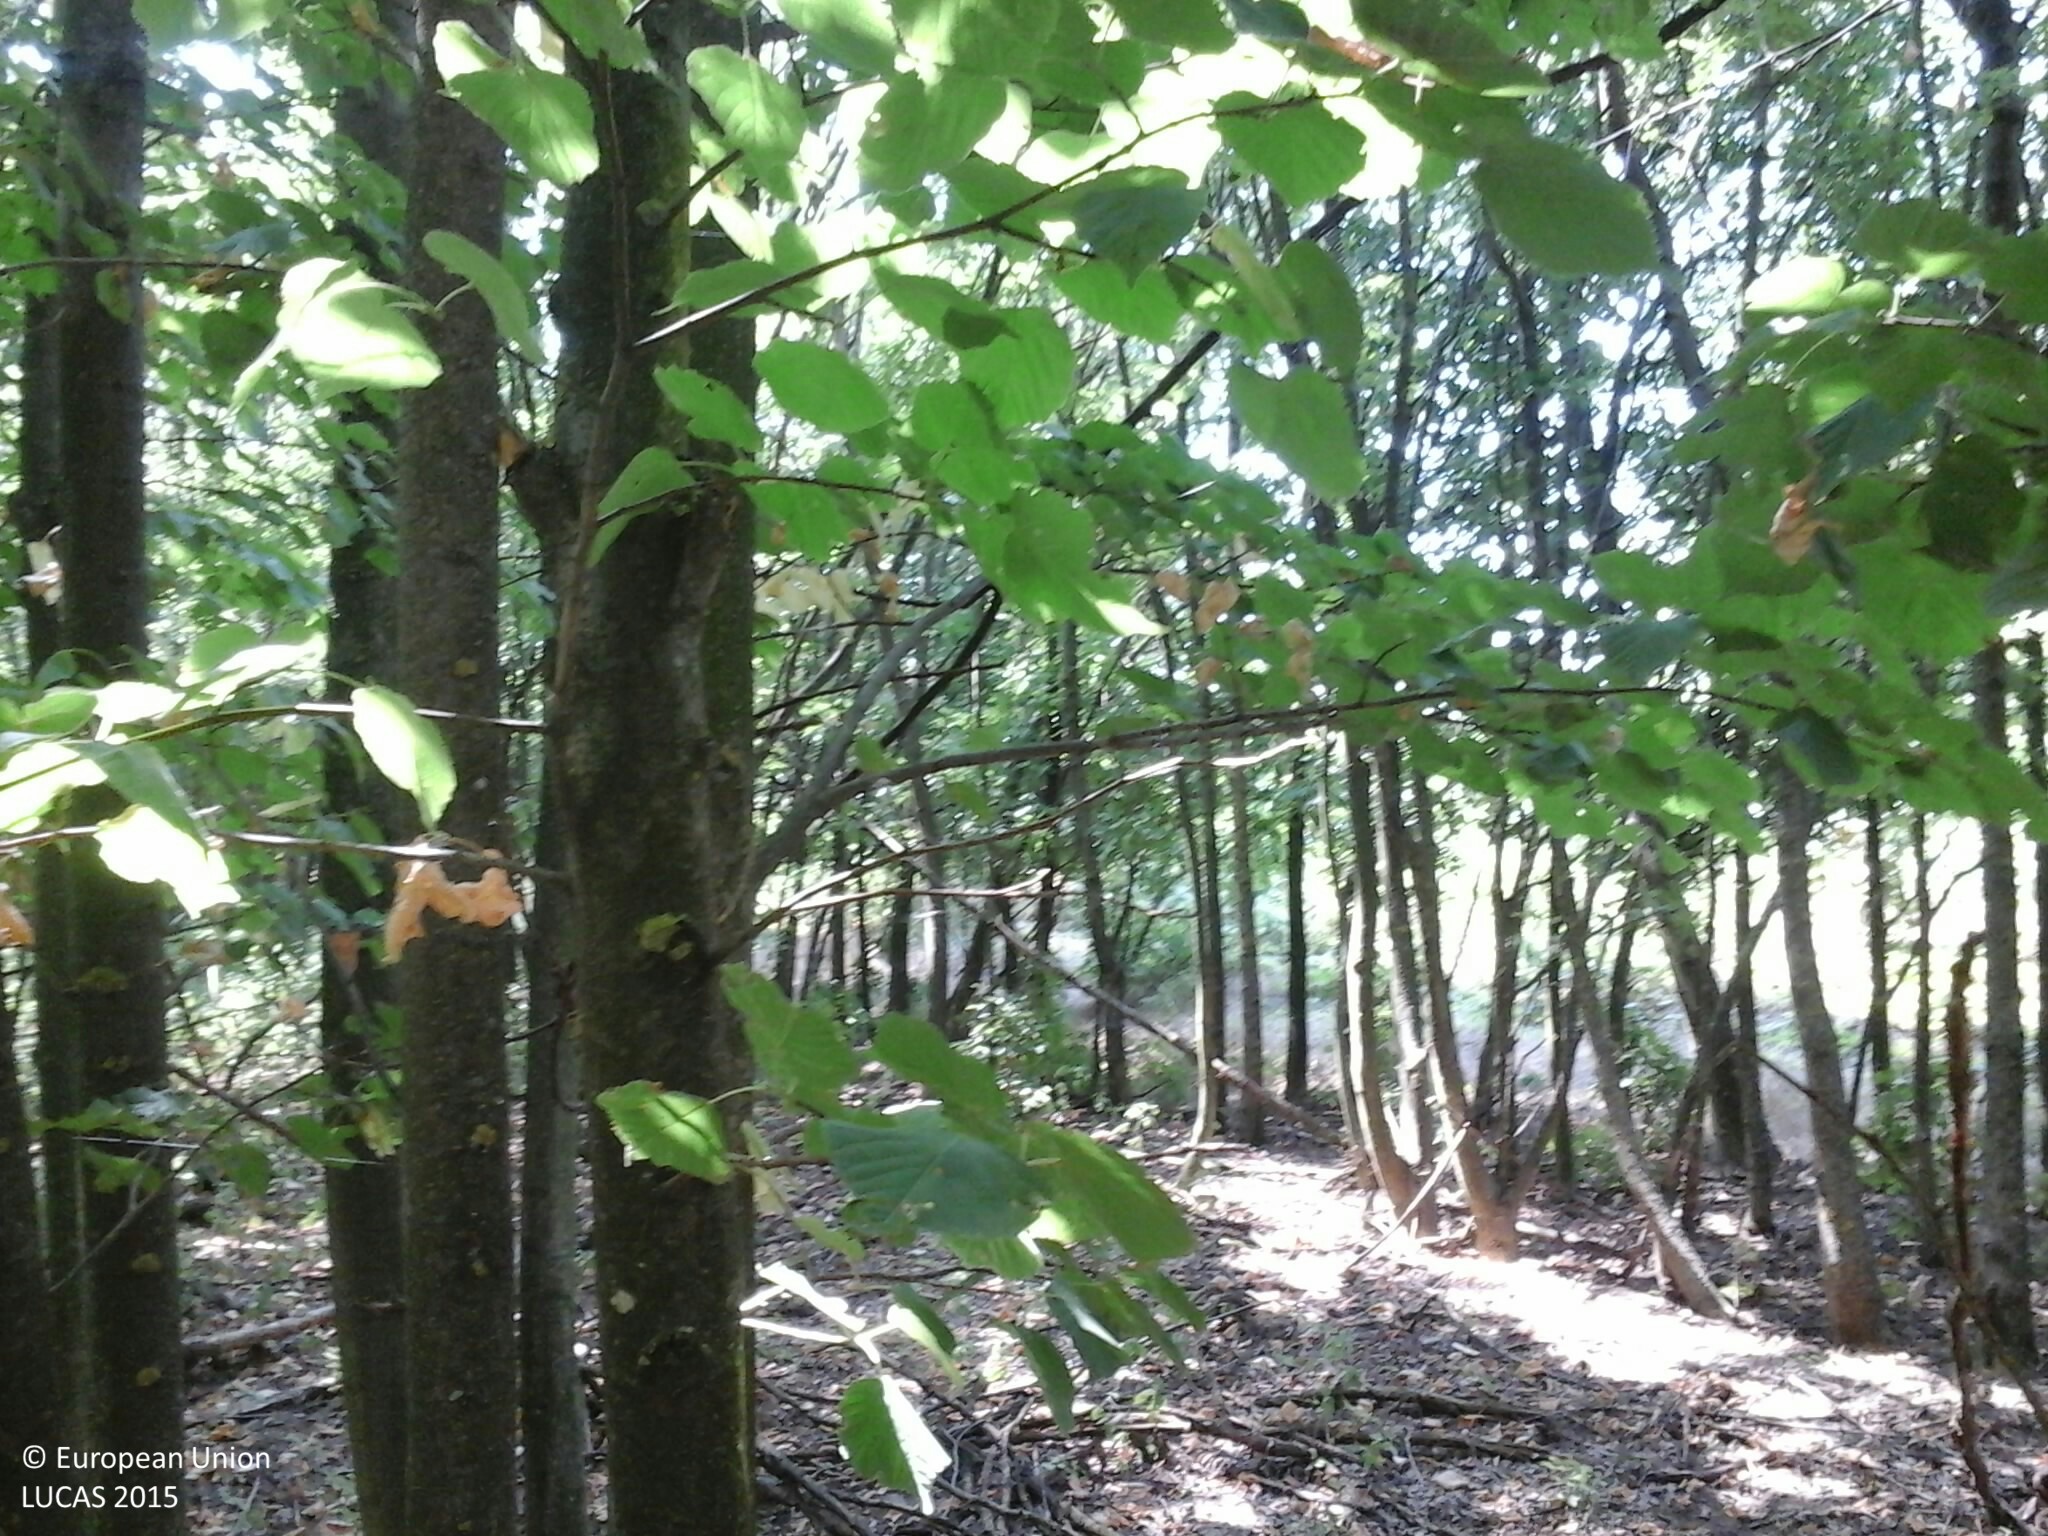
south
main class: Woodland
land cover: Broadleaved woodland
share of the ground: > 75 %
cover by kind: broadleaved forest trees 100 %
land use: Forestry
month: August
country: HU
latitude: 46.9214
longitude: 18.2176
